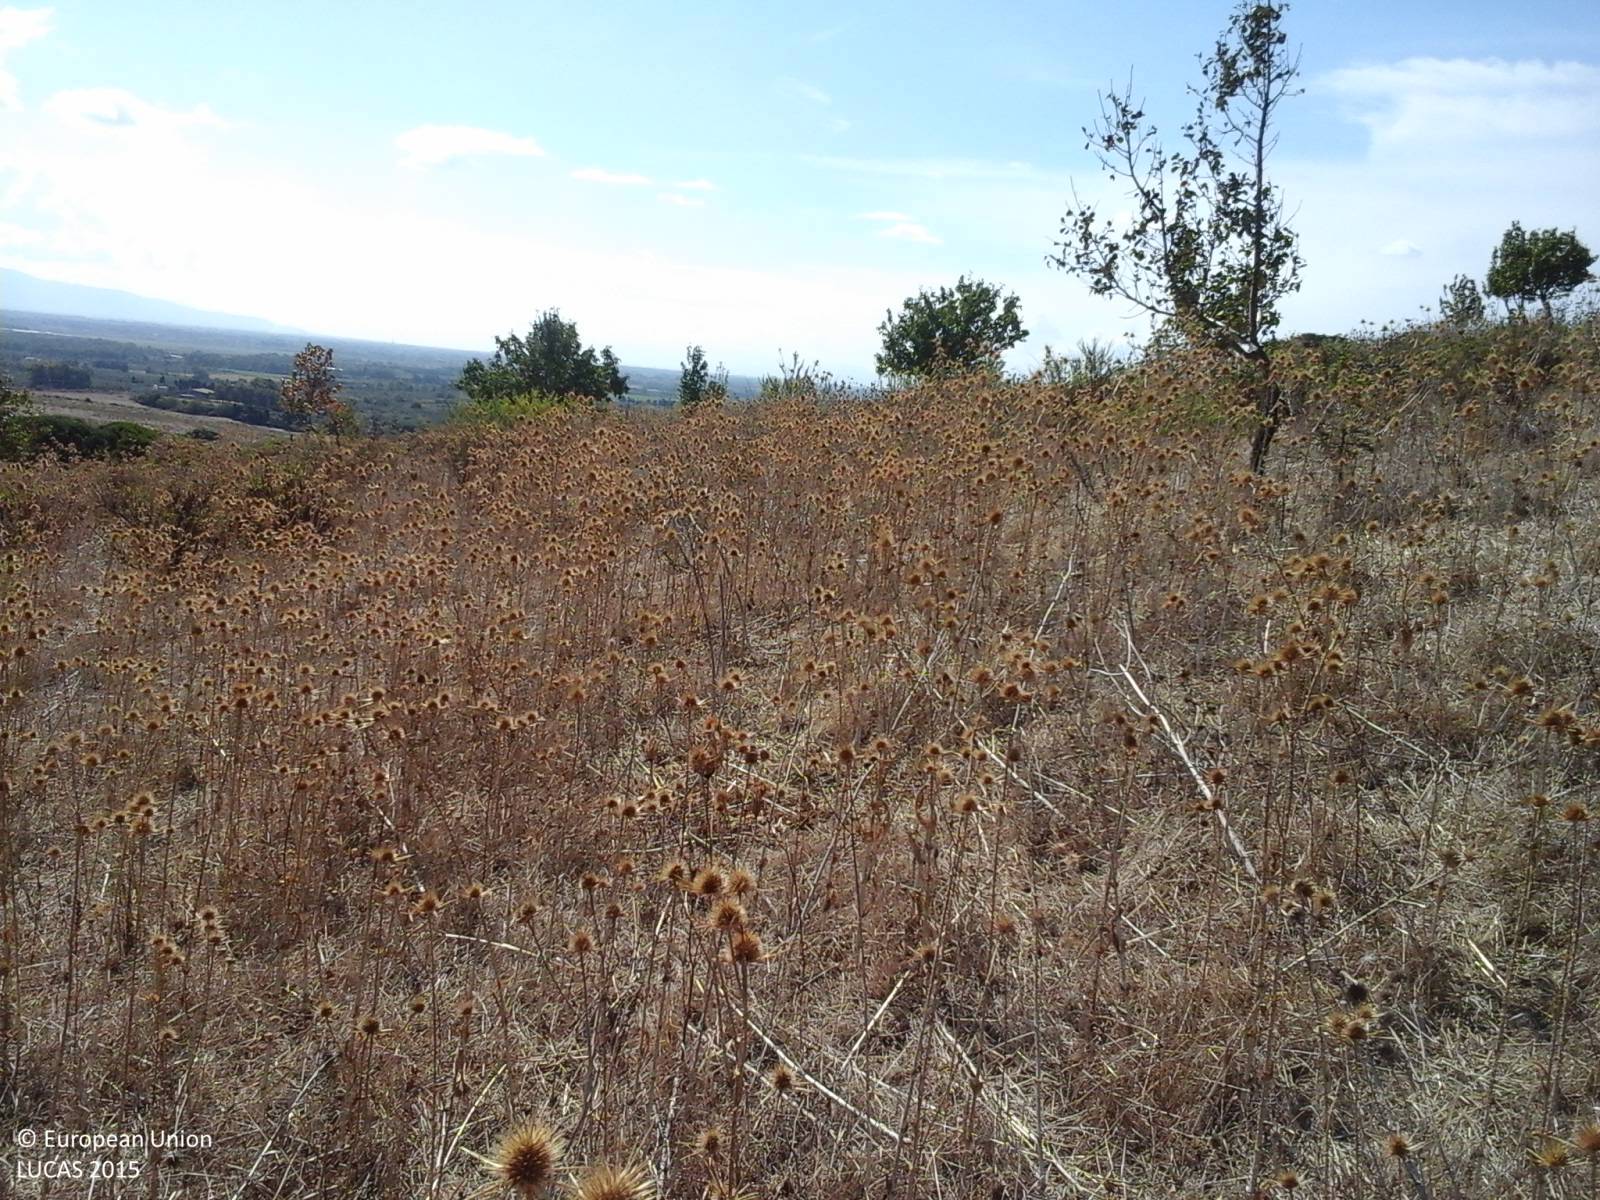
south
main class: Grassland
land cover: Grassland with sparse tree/shrub cover
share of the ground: > 75 %
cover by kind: herbaceous plants 90 %, broadleaved forest trees 5 %, shrubs 5 %
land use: Agriculture (excluding fallow land and kitchen gardens)
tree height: < 5 m
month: September
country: IT
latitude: 40.0392
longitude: 8.5429
